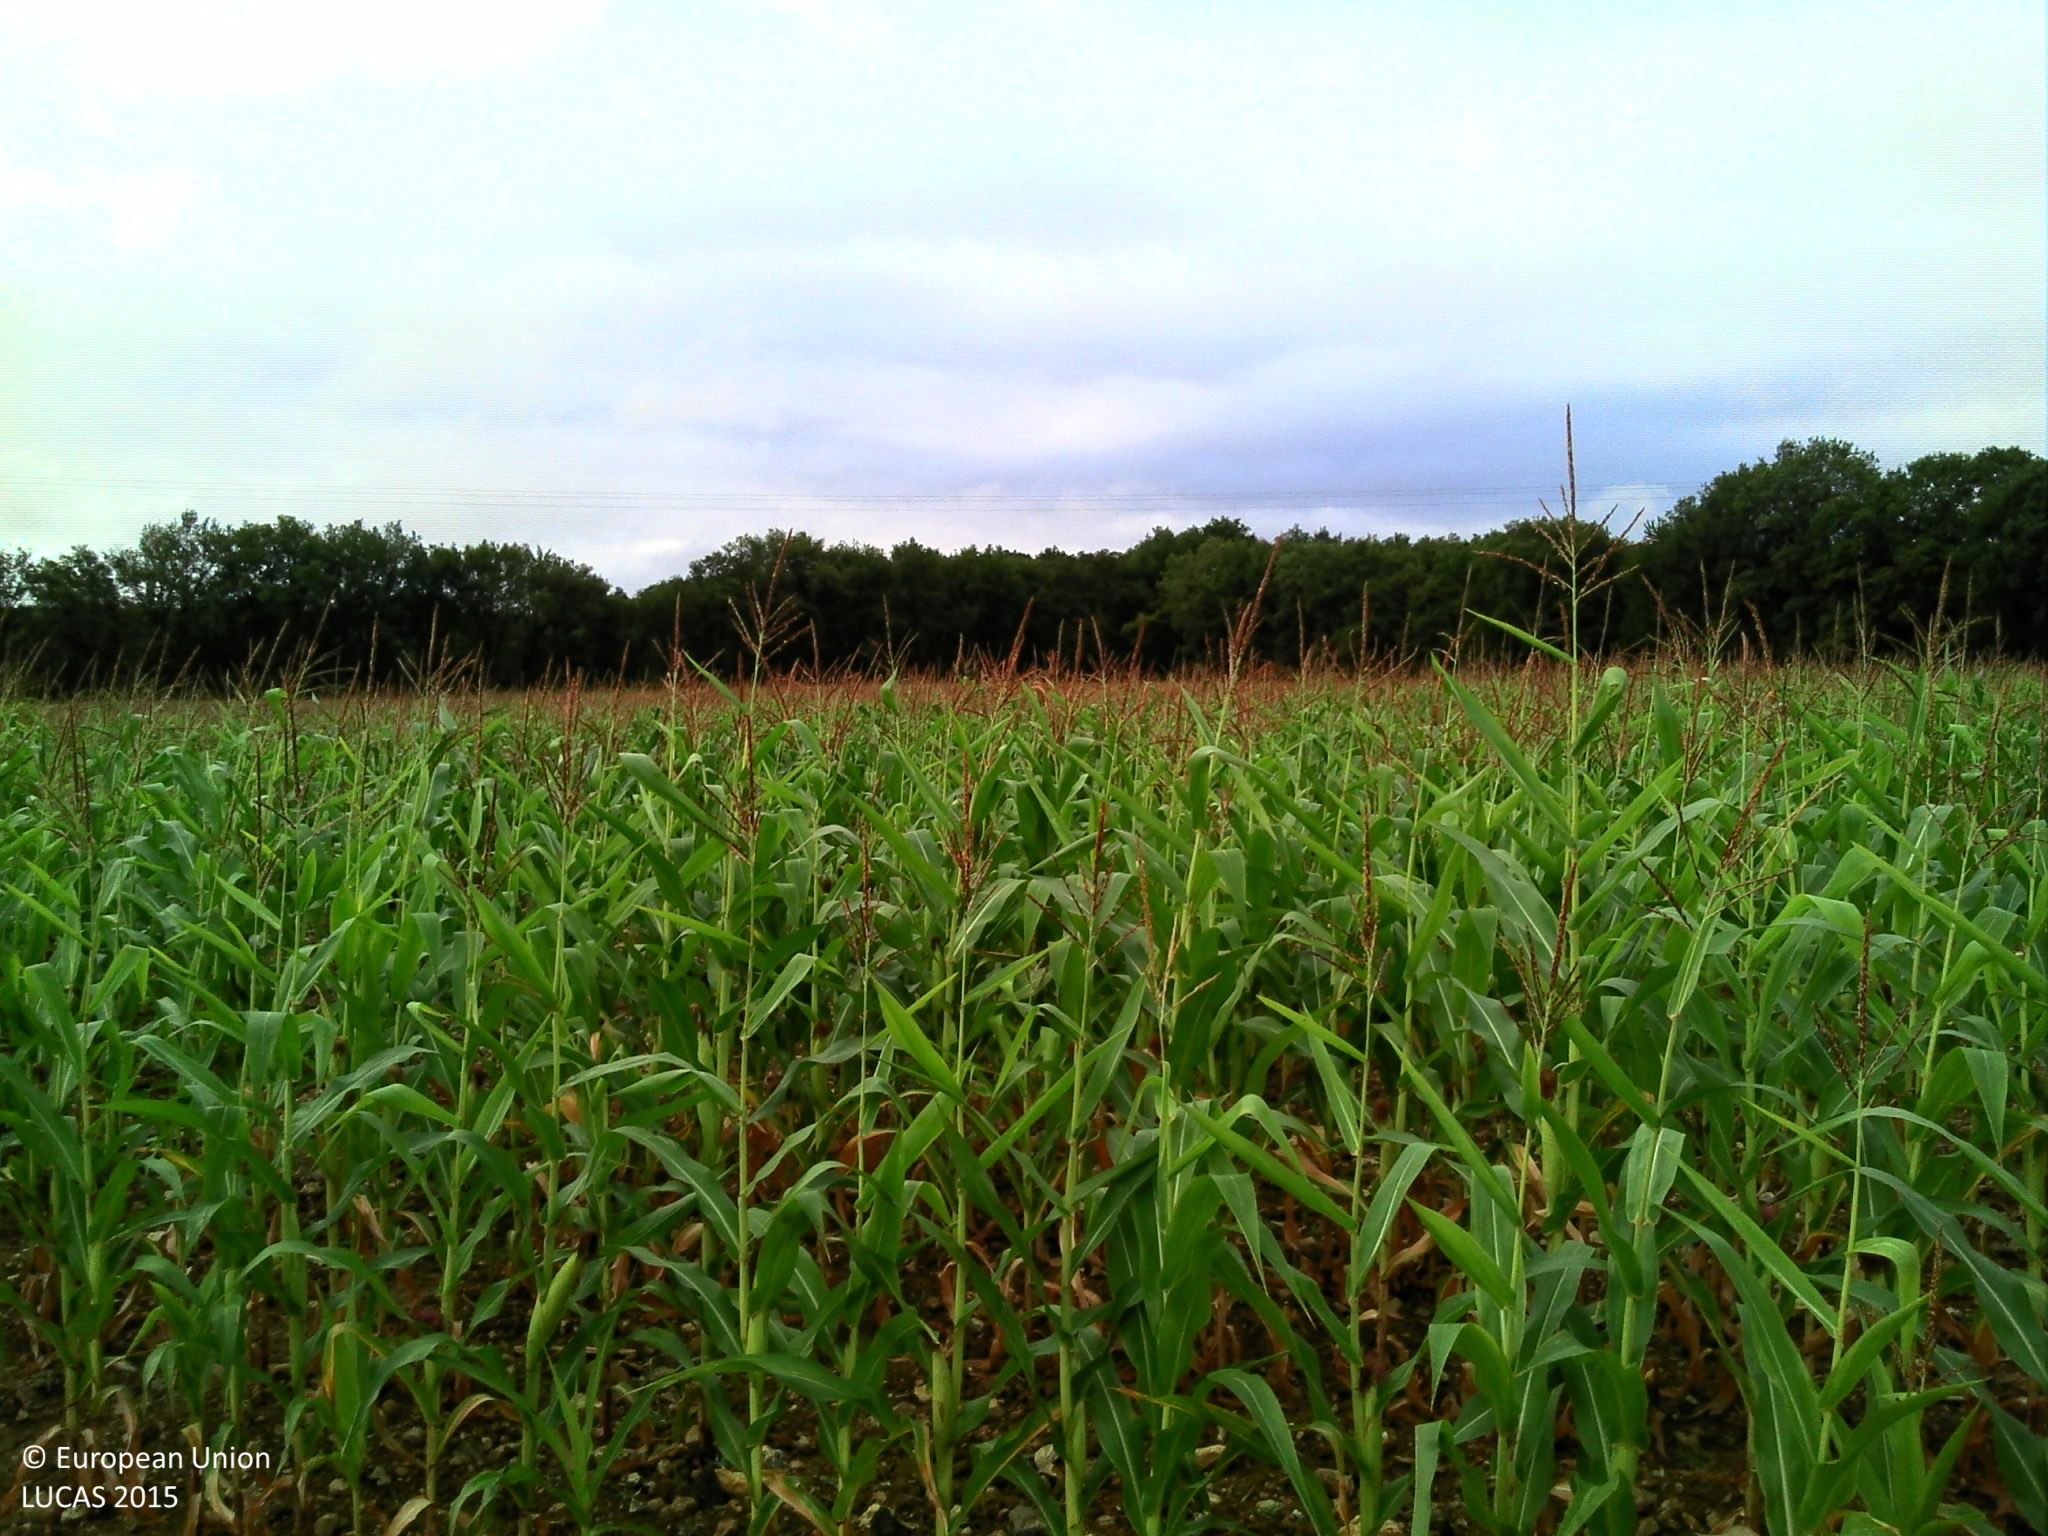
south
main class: Cropland
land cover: Maize
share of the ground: > 75 %
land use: Agriculture (excluding fallow land and kitchen gardens)
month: July
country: FR
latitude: 46.4625
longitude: 0.2012
